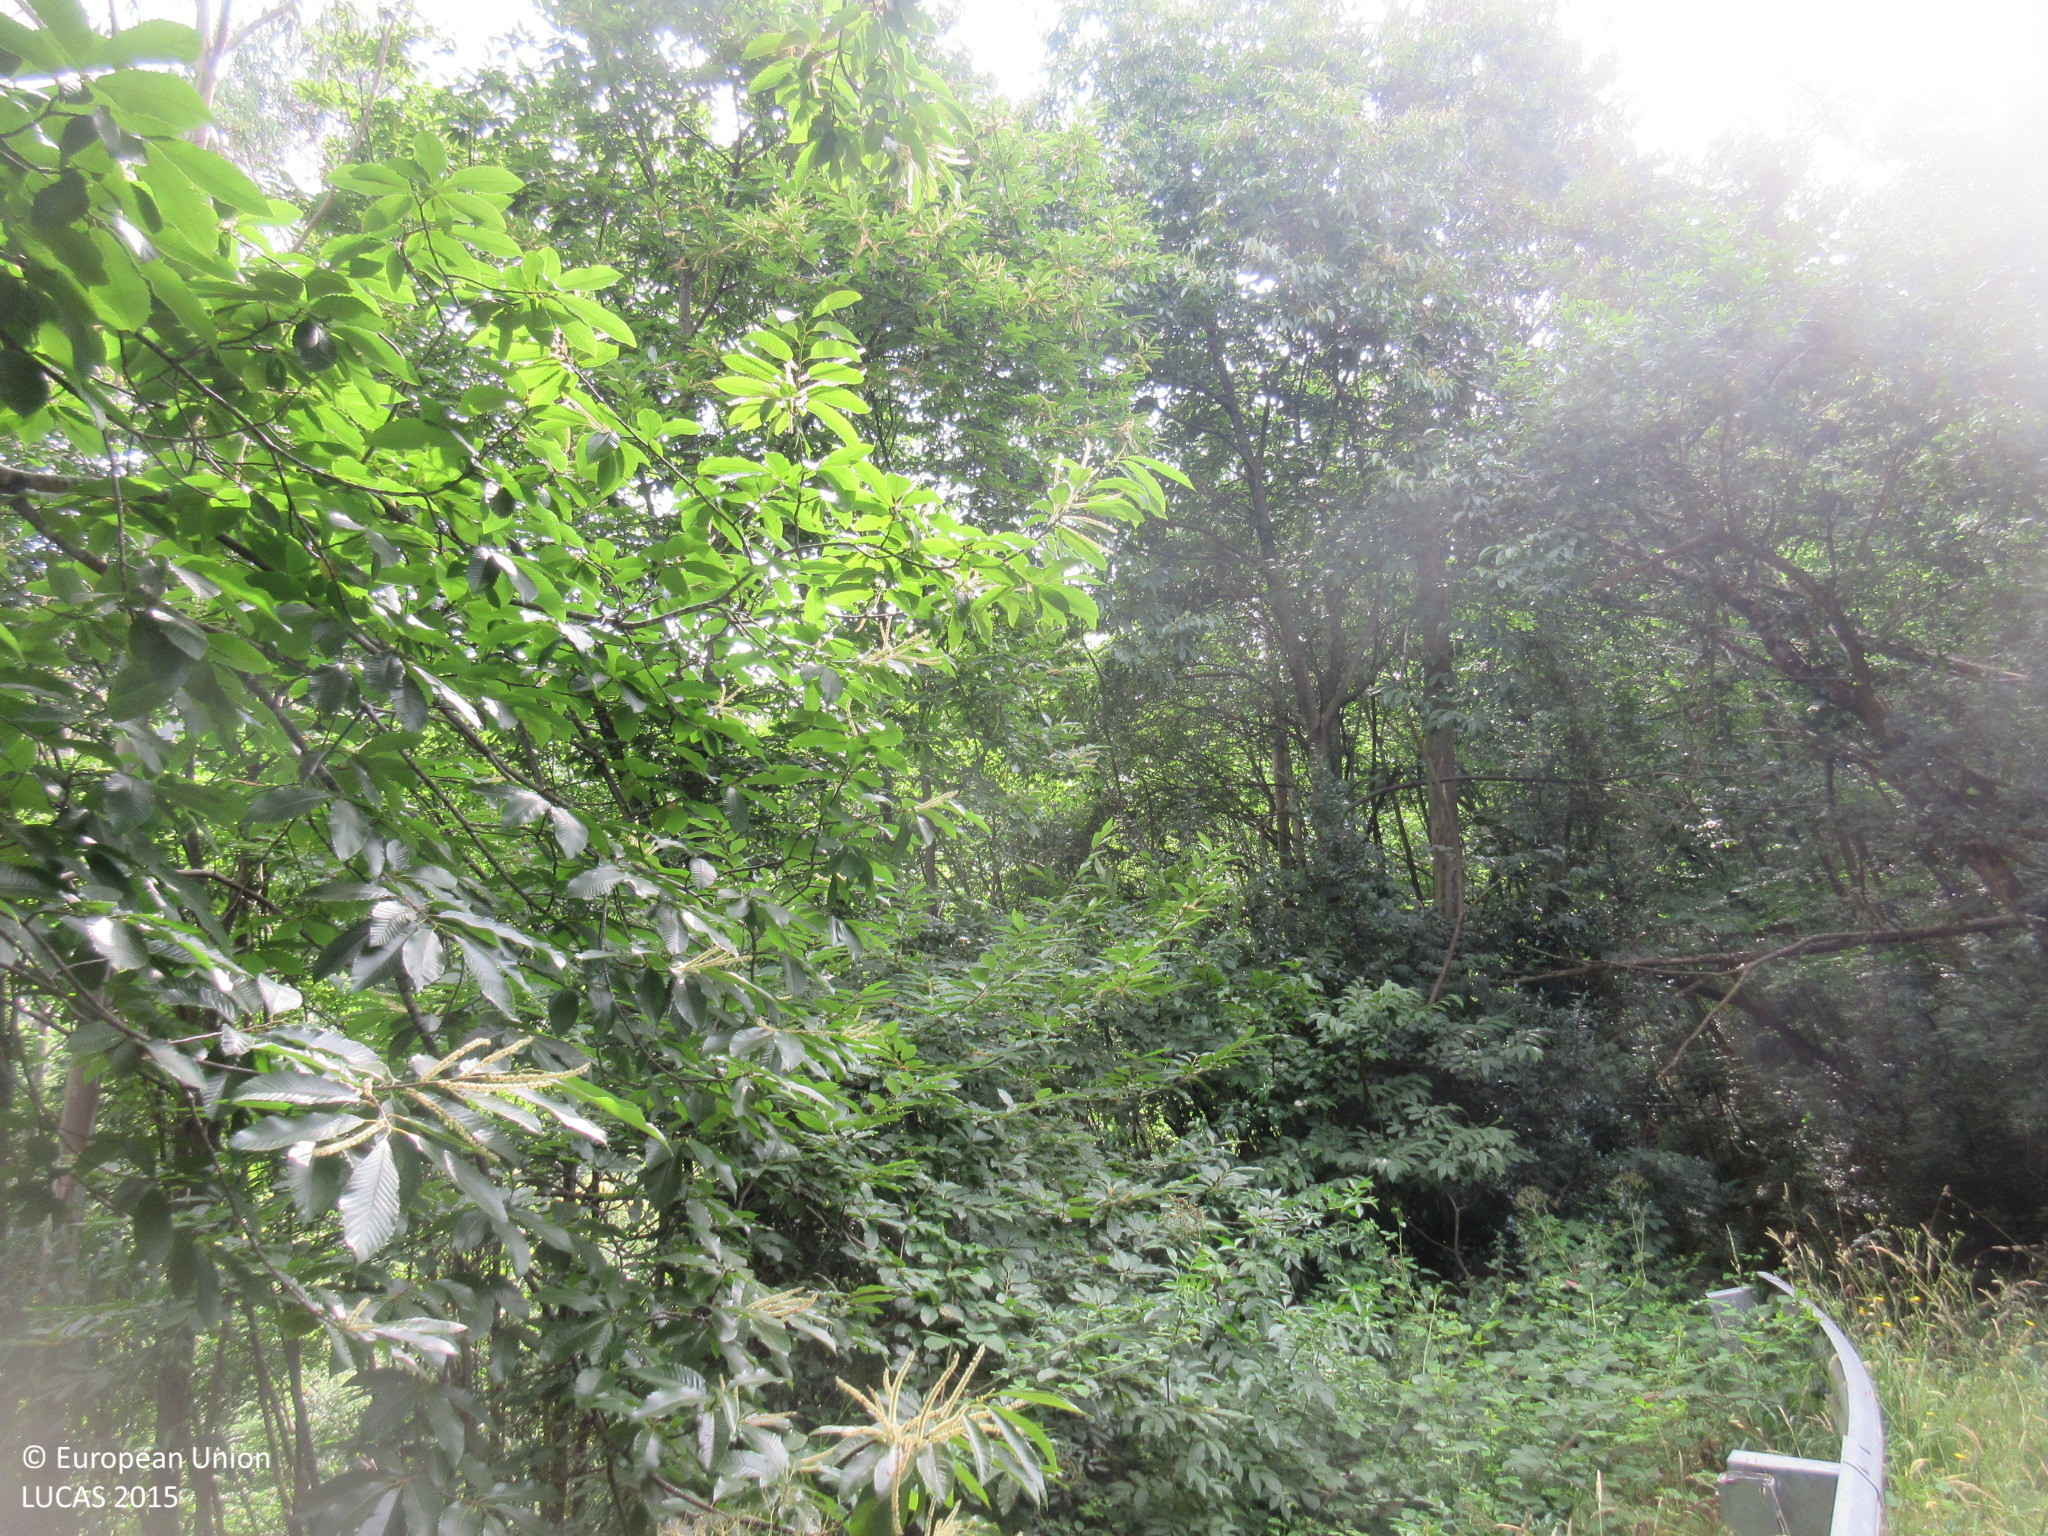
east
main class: Woodland
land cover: Broadleaved woodland
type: thermophilous deciduous forest
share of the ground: > 75 %
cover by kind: broadleaved forest trees 95 %, shrubs 5 %
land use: Forestry
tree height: > 5 m
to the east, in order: Broadleaved woodland
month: July
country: ES
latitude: 43.4474
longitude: -6.3495
